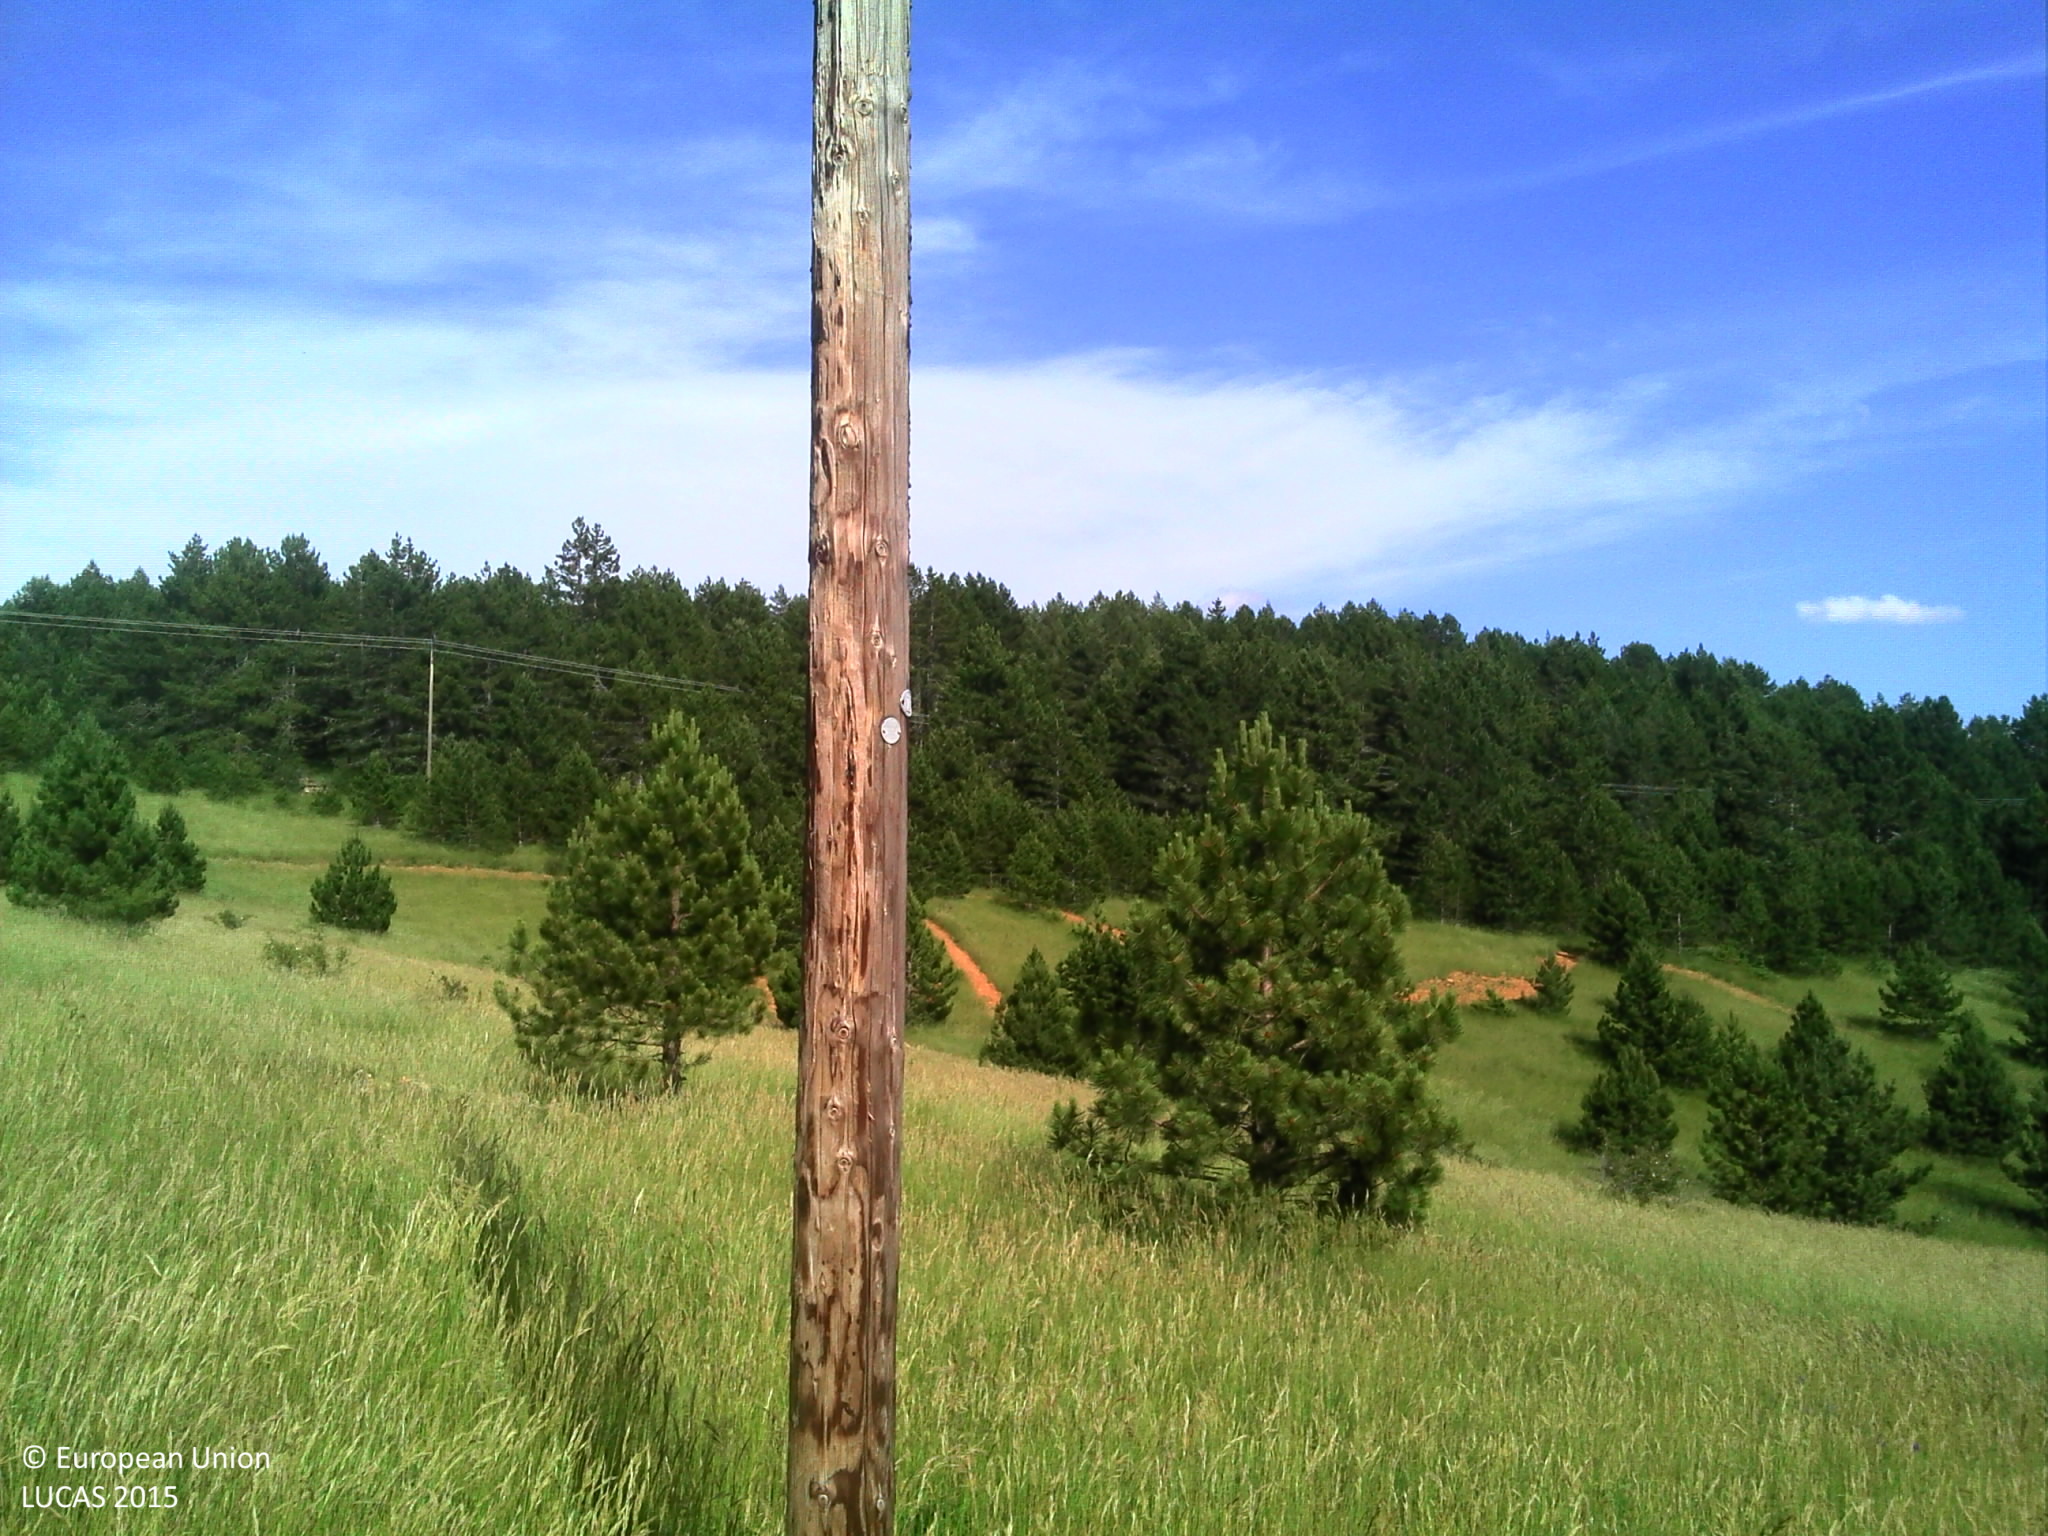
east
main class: Grassland
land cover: Grassland with sparse tree/shrub cover
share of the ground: > 75 %
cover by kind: herbaceous plants 90 %, coniferous forest trees 5 %, shrubs 5 %
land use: Agriculture (excluding fallow land and kitchen gardens)
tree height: < 5 m
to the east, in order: Grassland with sparse tree/shrub cover; Electric lines; Tracks; Grassland with sparse tree/shrub cover; Tracks; Grassland with sparse tree/shrub cover; Pine dominated coniferous woodland; Electric lines; Pine dominated coniferous woodland; Shrubland without tree cover
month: June
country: FR
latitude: 44.5117
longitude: 3.5520
